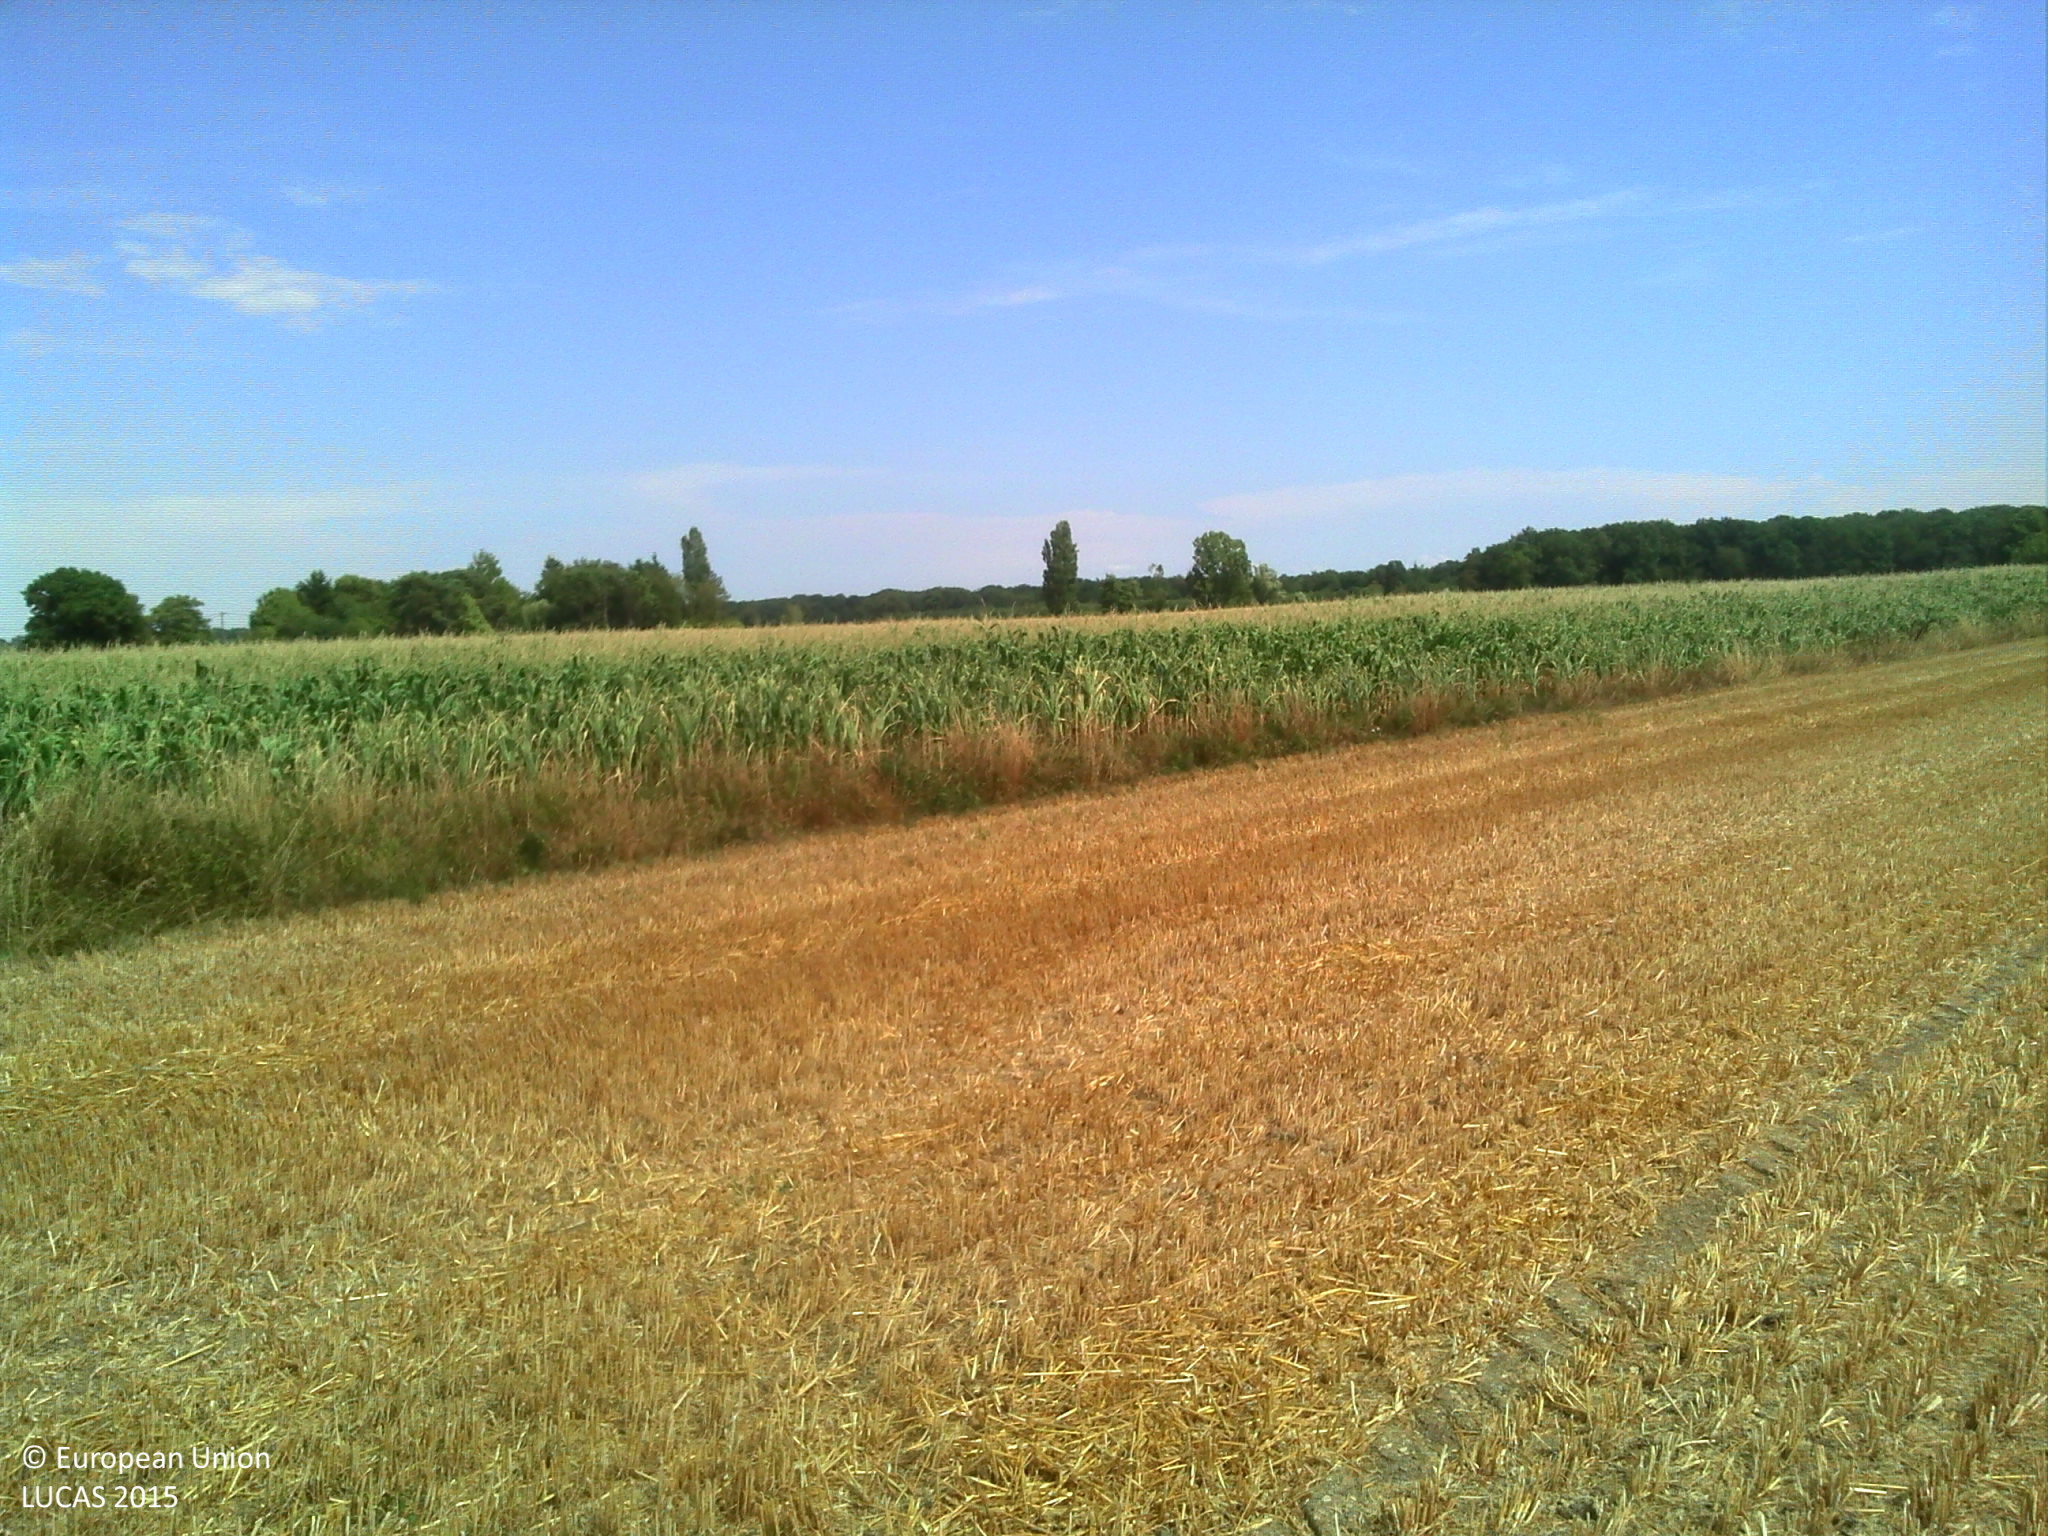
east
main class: Cropland
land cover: Barley
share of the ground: > 75 %
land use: Agriculture (excluding fallow land and kitchen gardens)
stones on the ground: 10 - 25 %
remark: Harvested field
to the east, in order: Barley; Ditches and canals; Maize; Common wheat
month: July
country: FR
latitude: 46.9341
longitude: 4.9178
